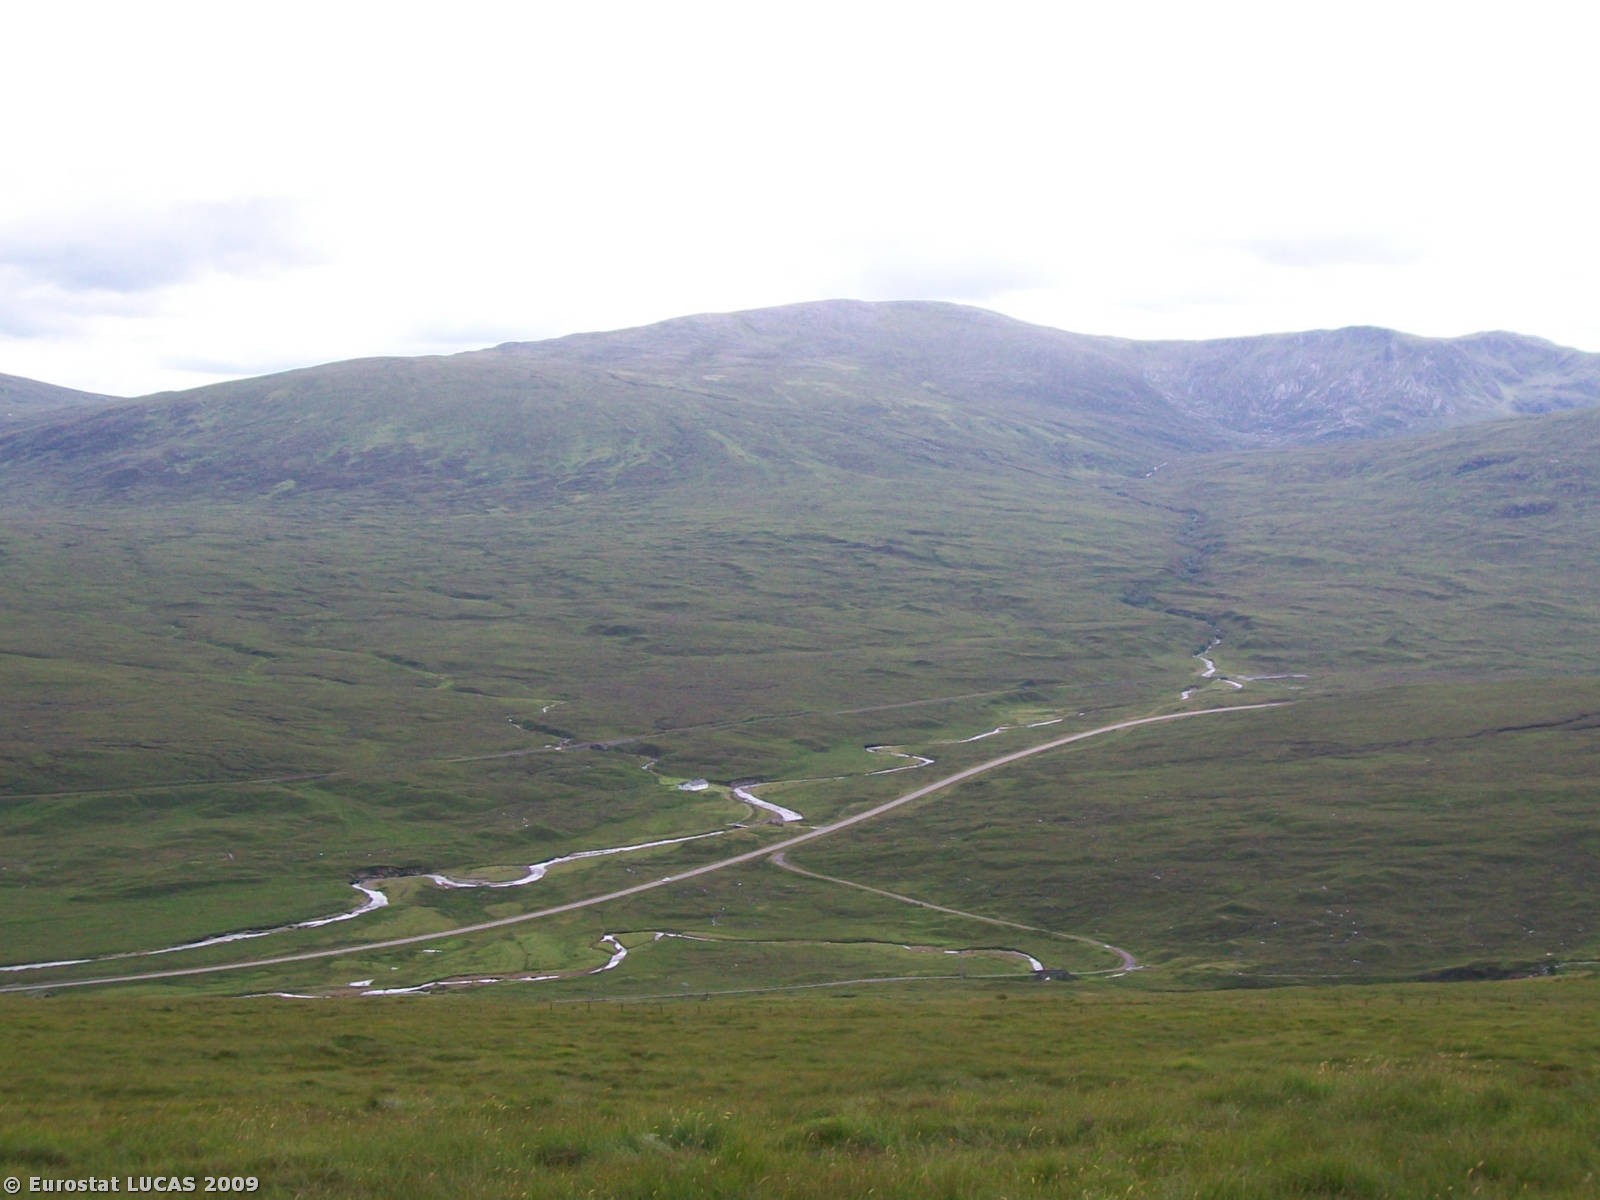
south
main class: Grassland
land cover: Grassland without tree/shrub cover
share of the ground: > 75 %
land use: Agriculture (excluding fallow land and kitchen gardens)
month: July
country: GB
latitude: 57.5573
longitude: -5.1308
